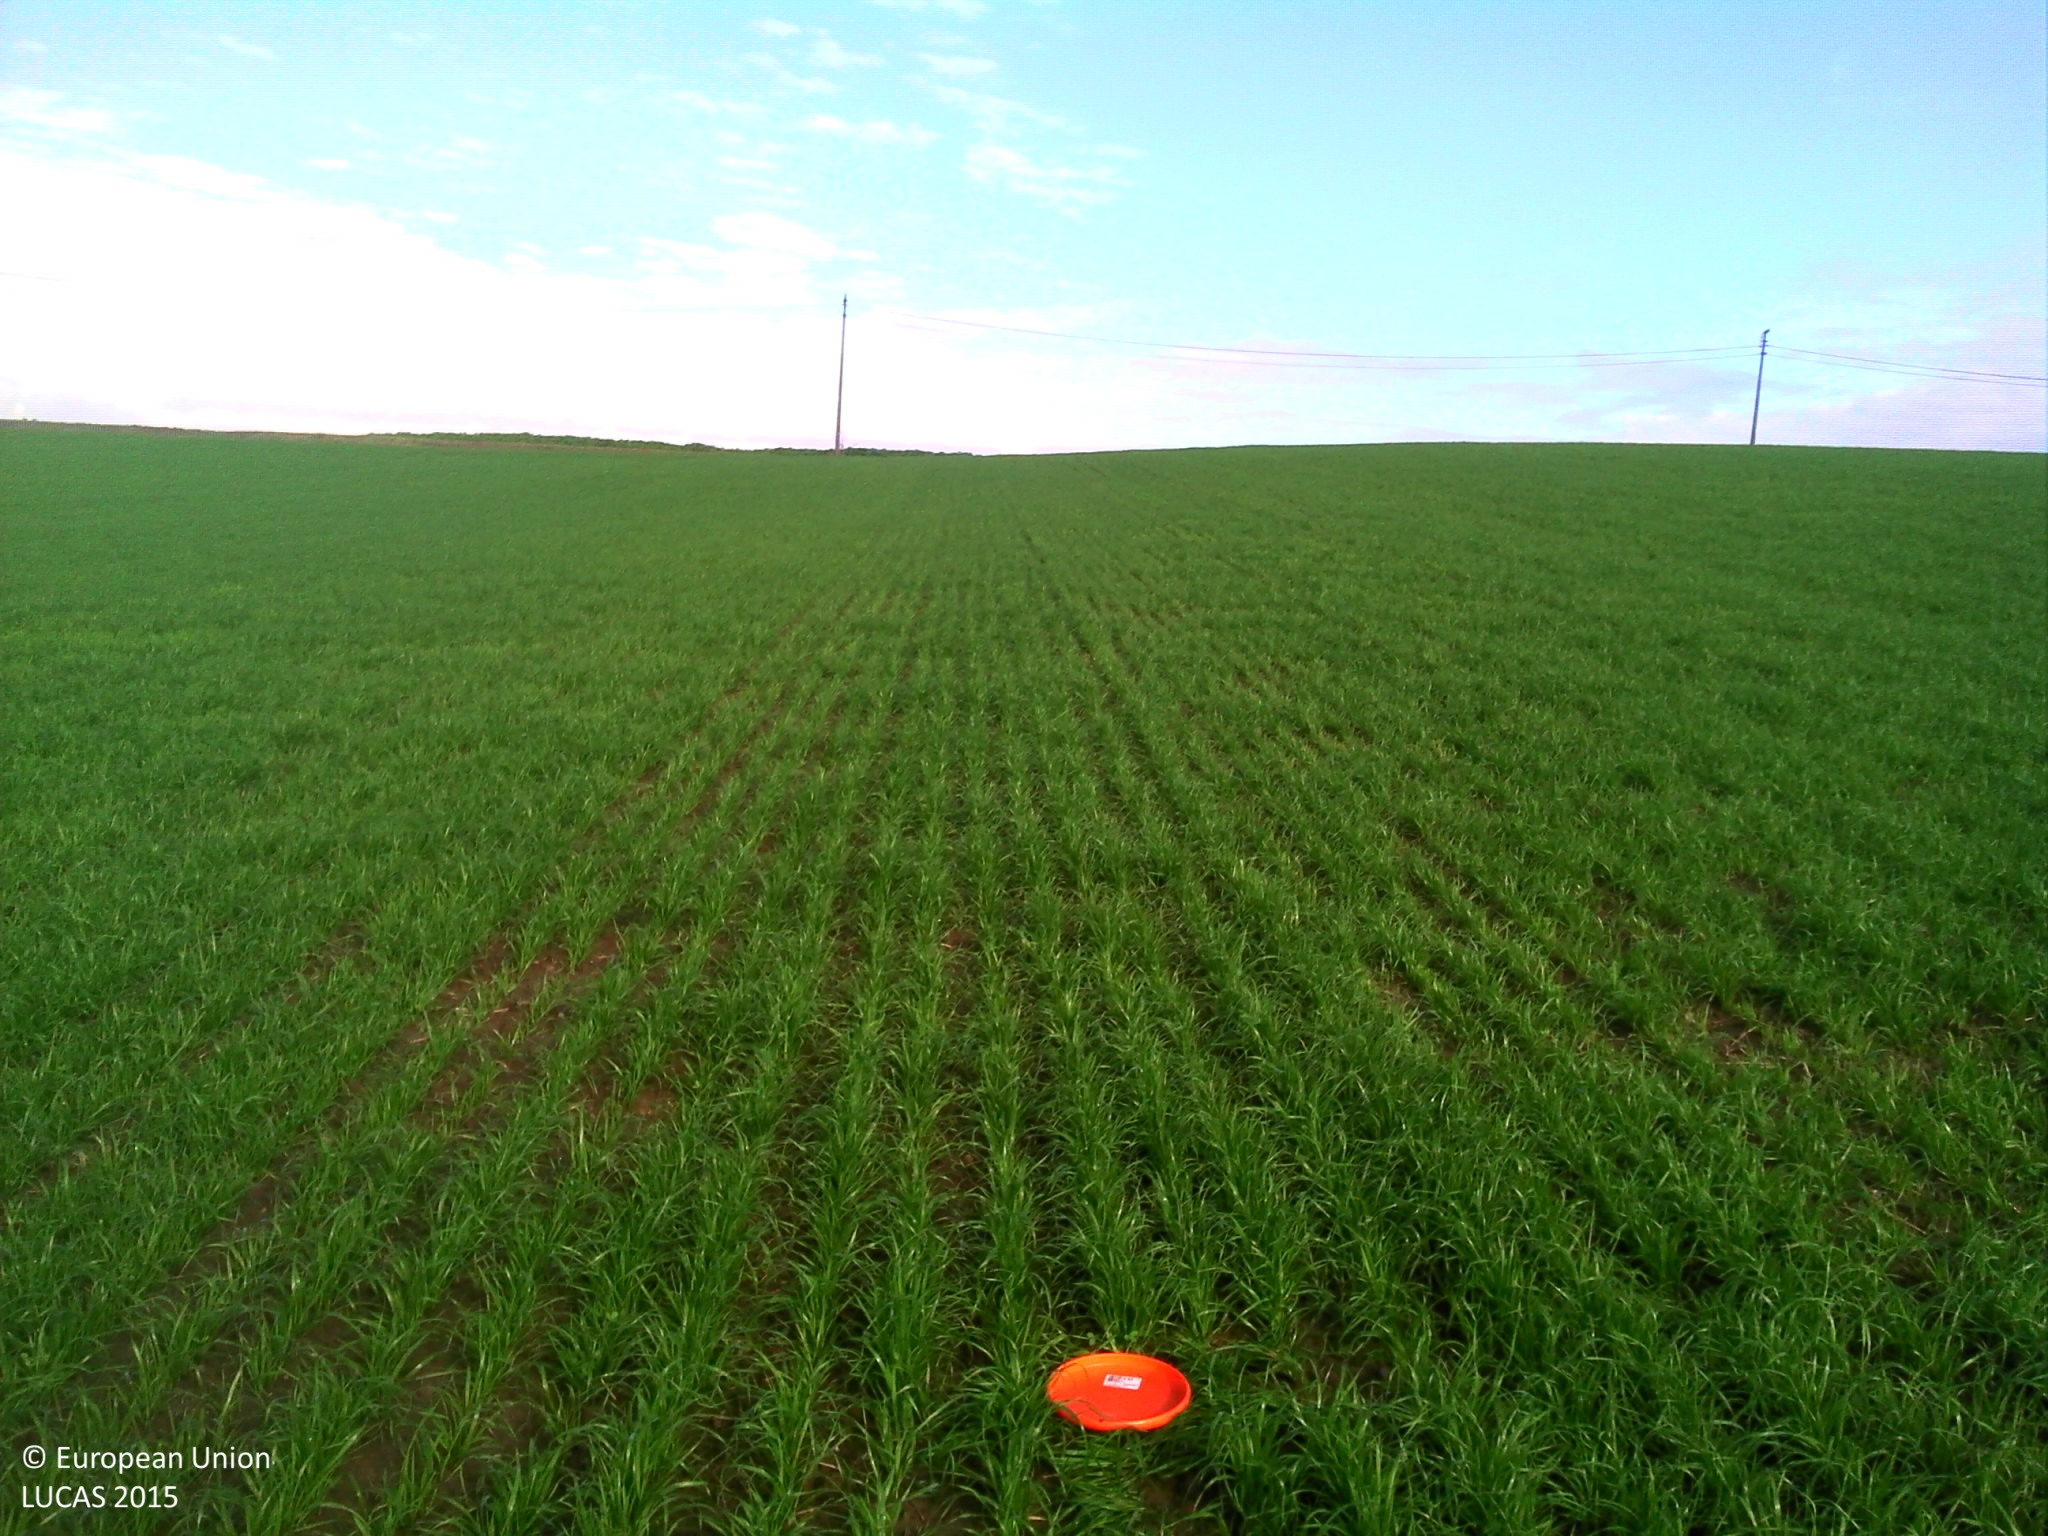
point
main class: Cropland
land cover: Temporary grasslands
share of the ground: > 75 %
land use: Agriculture (excluding fallow land and kitchen gardens)
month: October
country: BE
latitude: 50.6922
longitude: 3.9778
